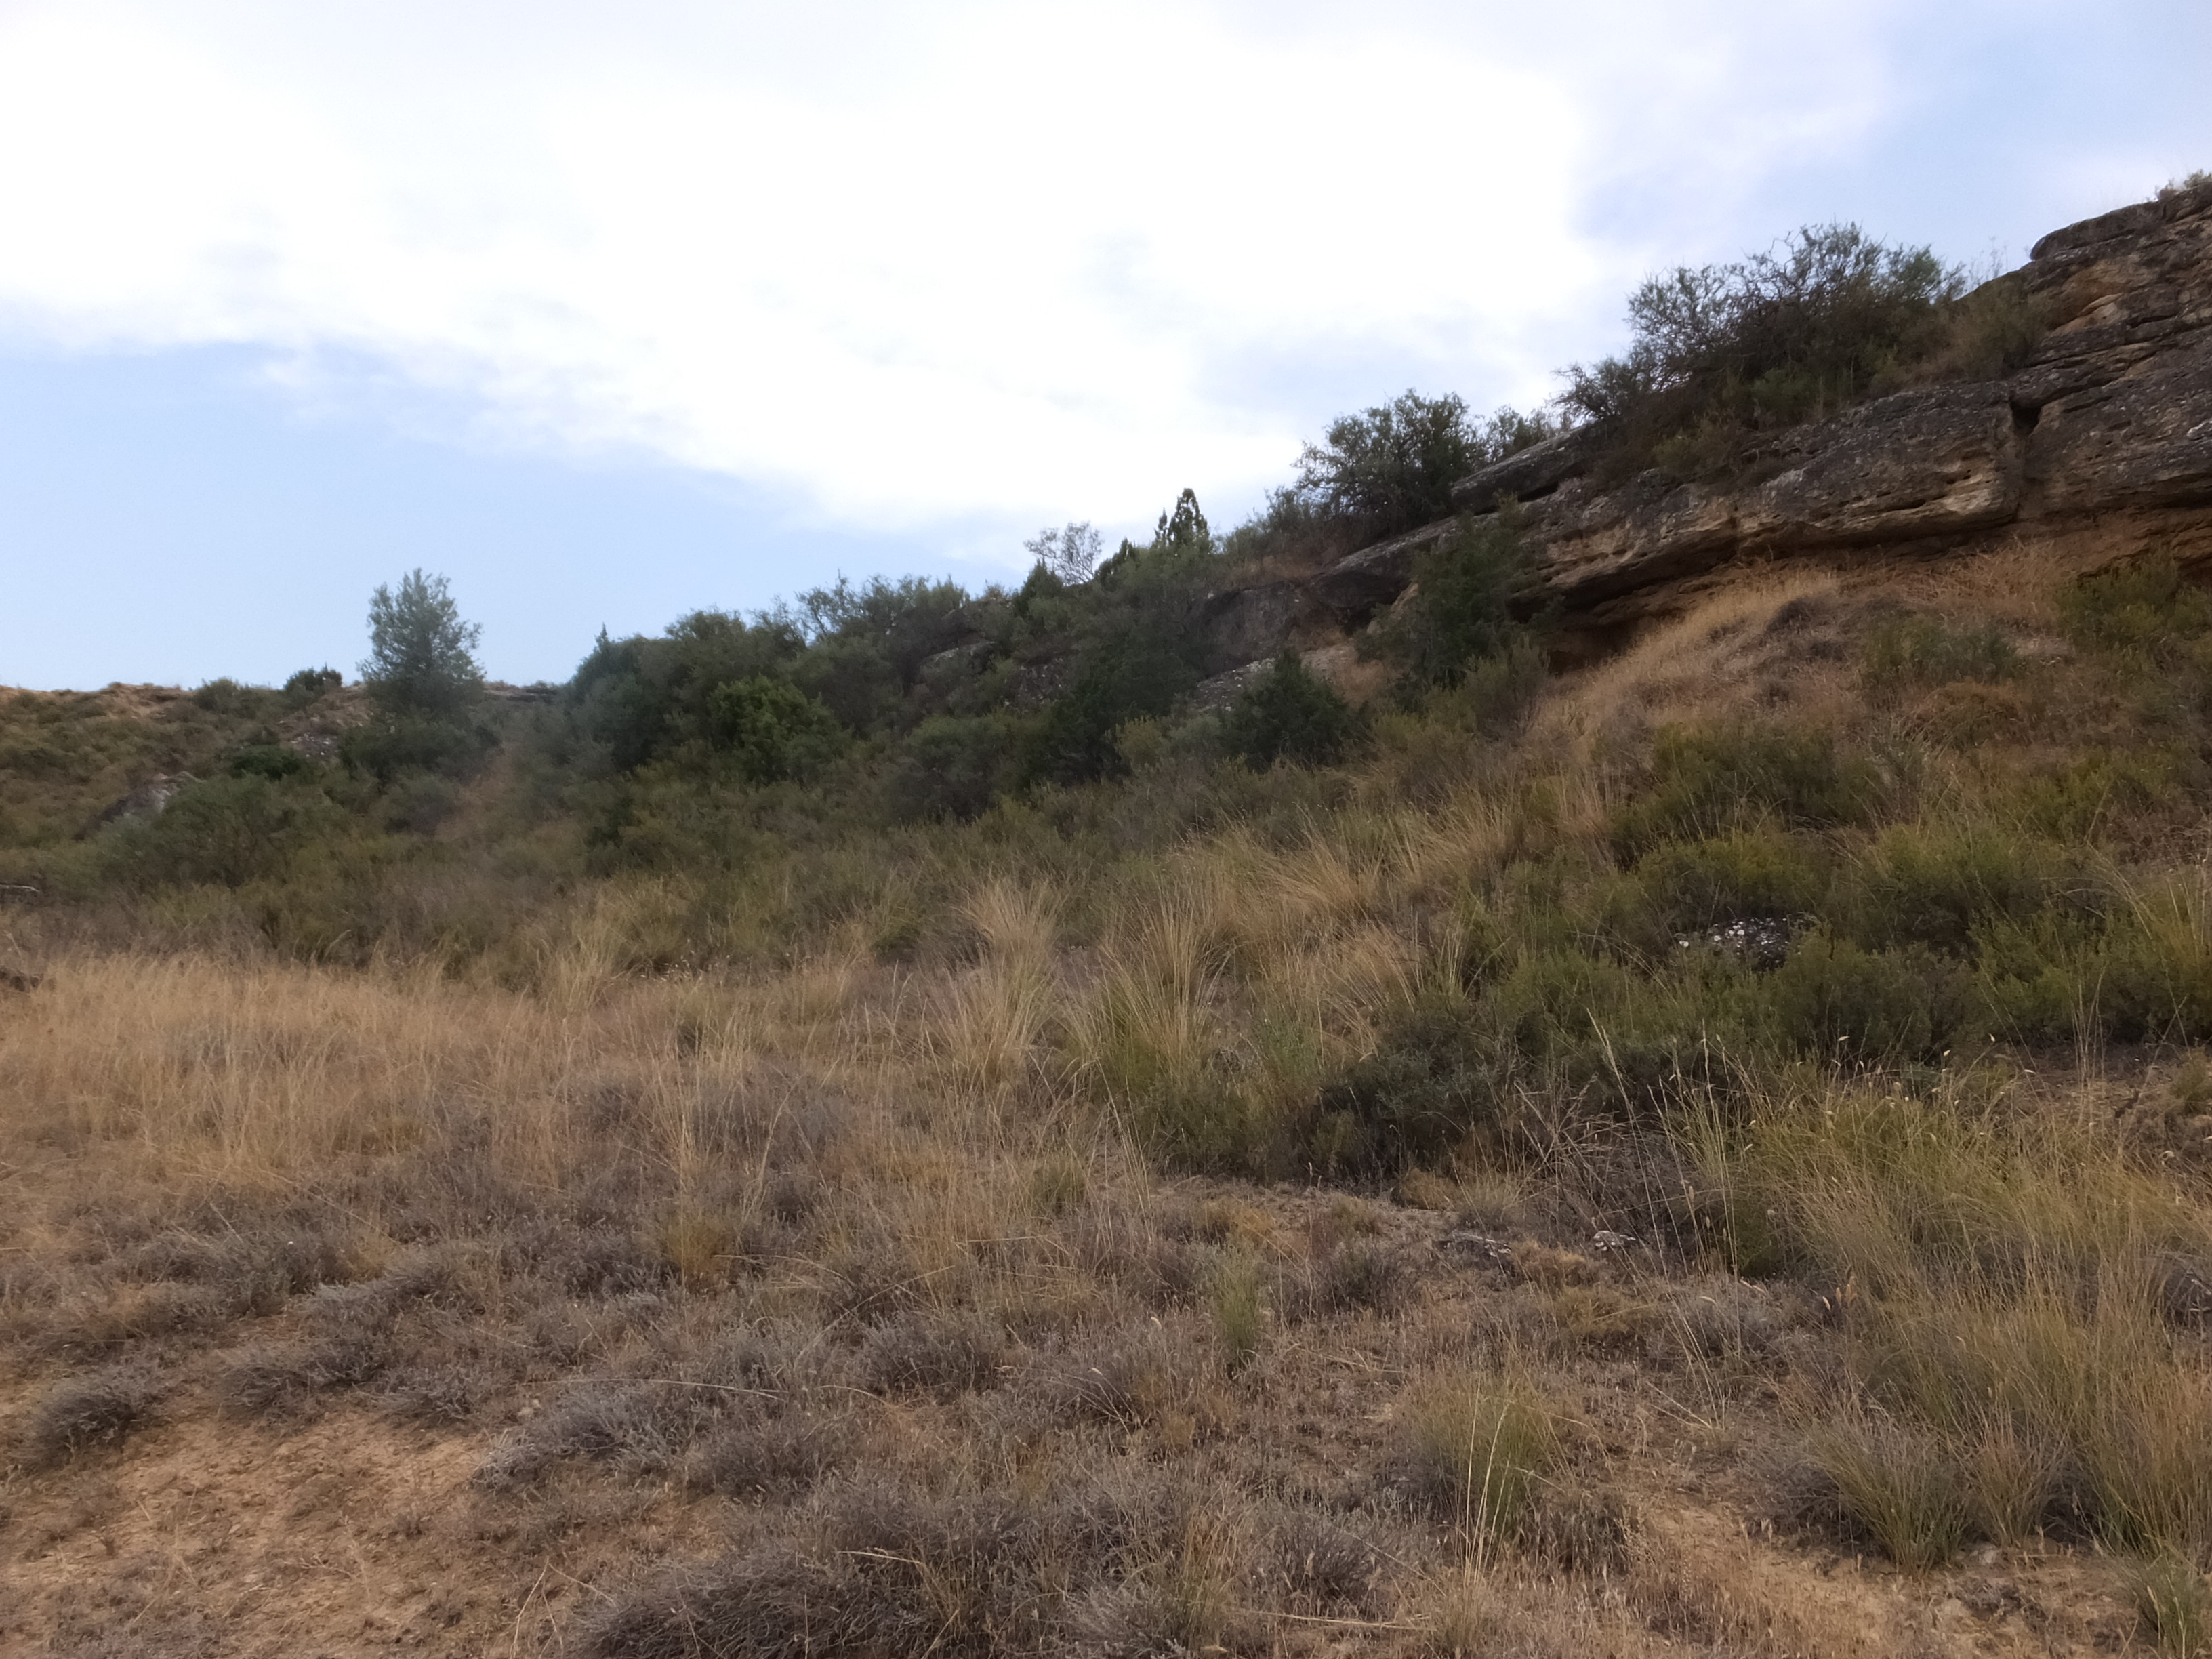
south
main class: Grassland
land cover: Grassland without tree/shrub cover
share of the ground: > 75 %
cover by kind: herbaceous plants 95 %, shrubs 5 %
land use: Semi-natural and natural areas not in use
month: July
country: ES
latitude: 41.2232
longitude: -0.0686
